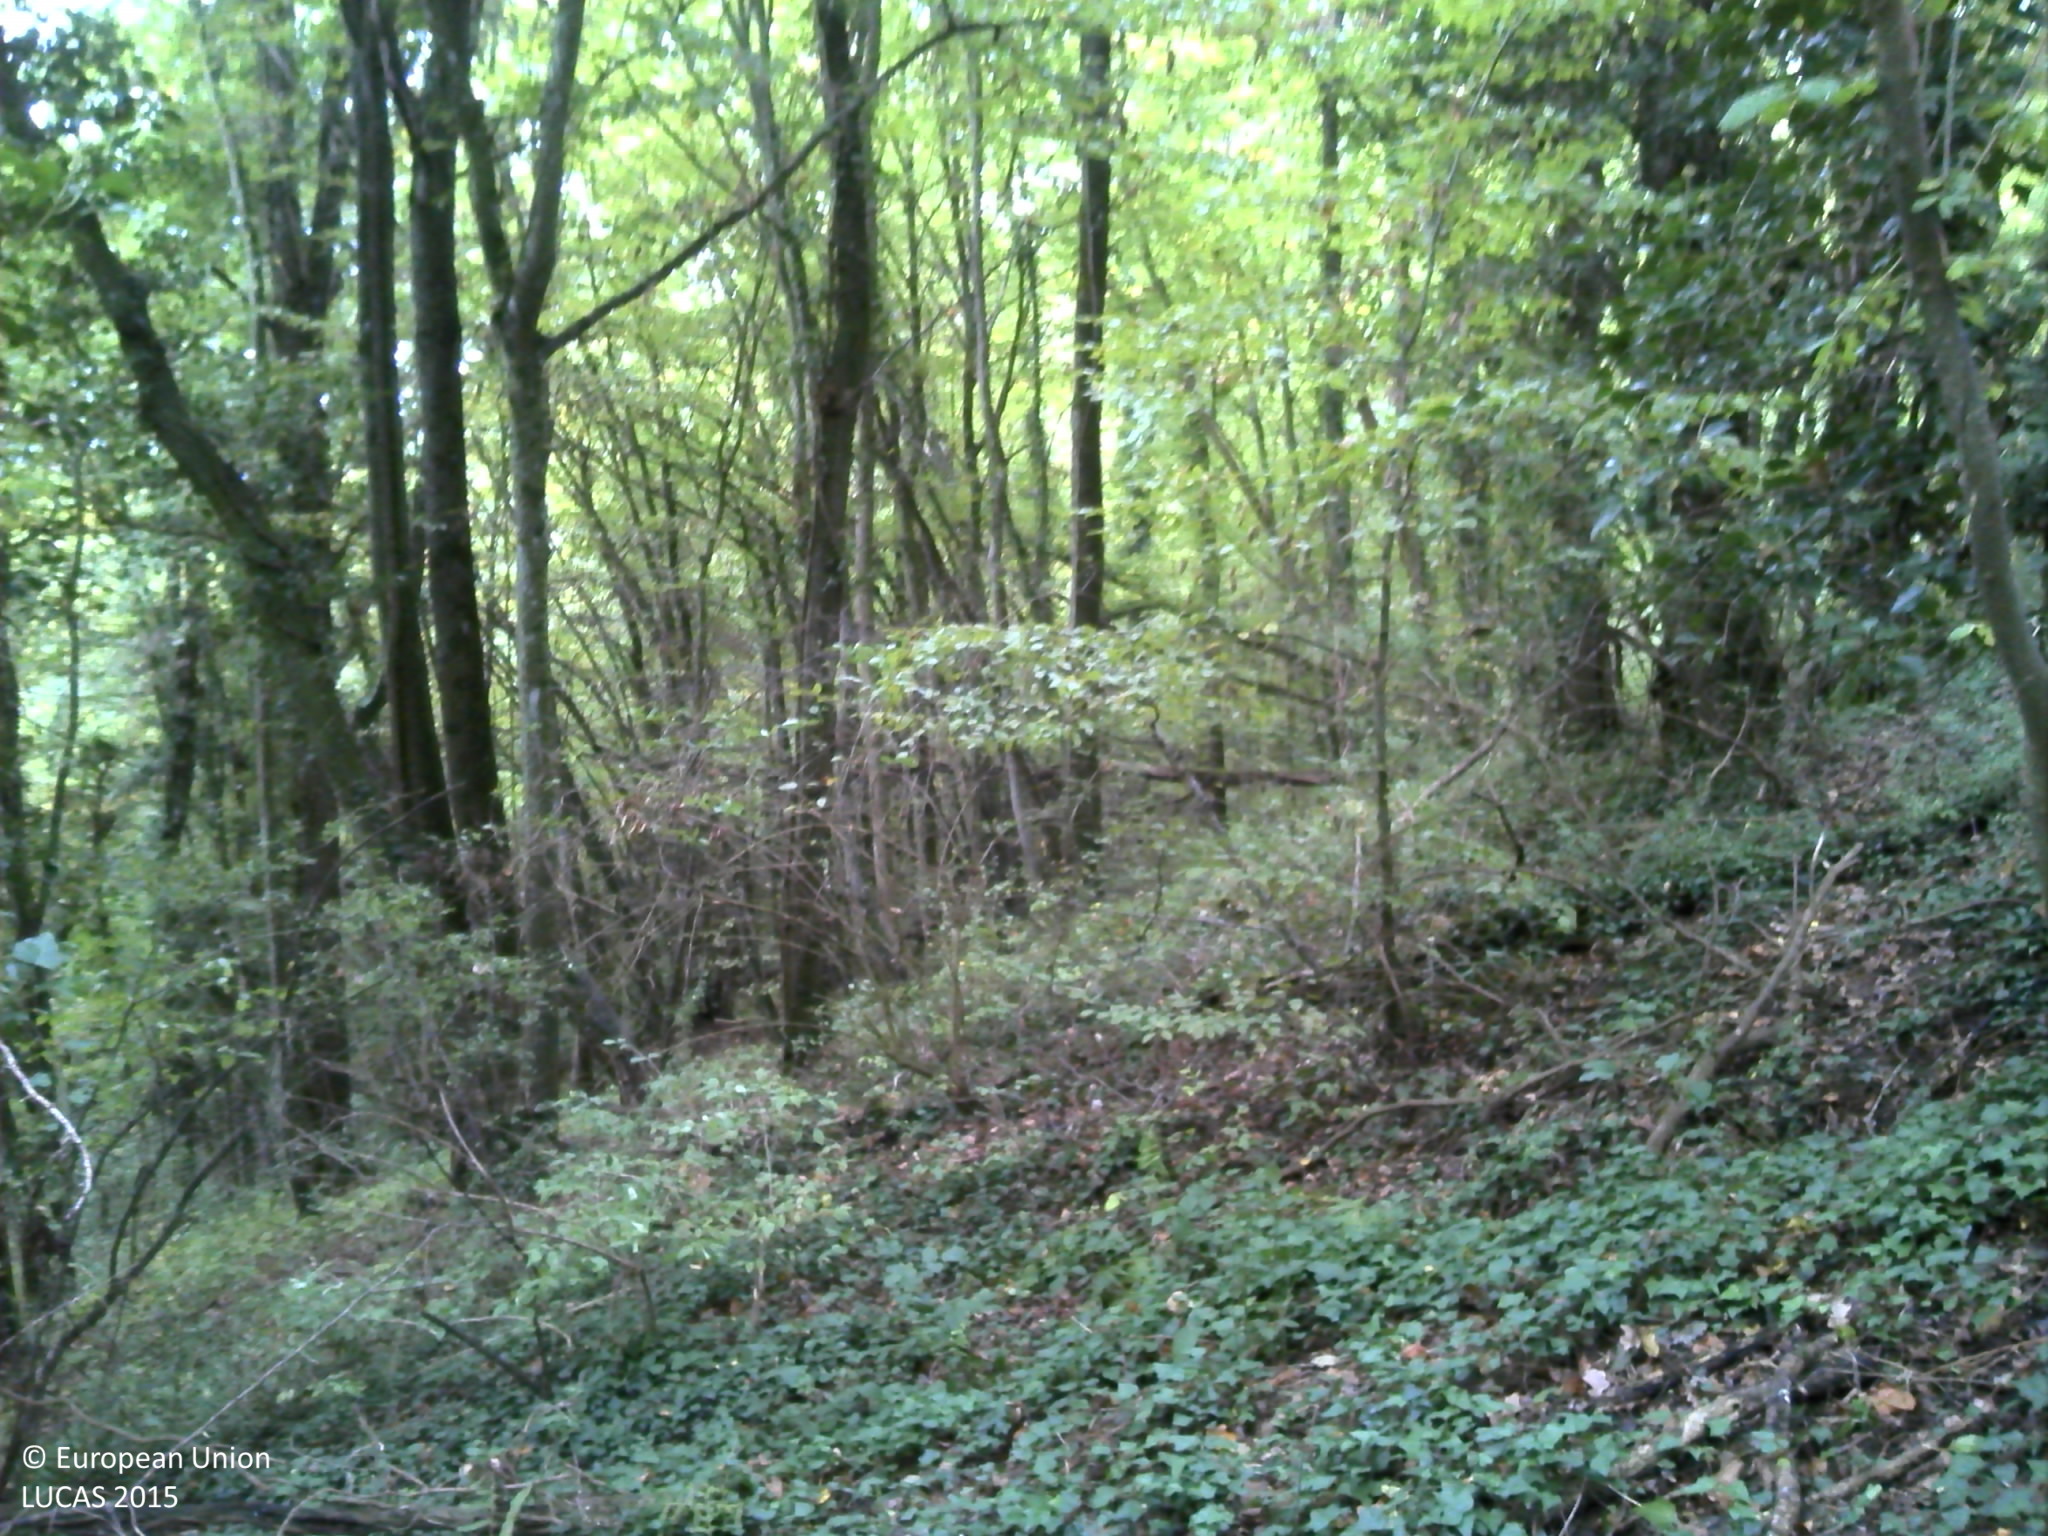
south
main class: Woodland
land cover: Broadleaved woodland
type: acidophilous oak and oak-birch forest
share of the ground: > 75 %
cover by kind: broadleaved forest trees 75 %, unconsolidated bare surface 15 %, herbaceous plants 10 %
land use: Forestry
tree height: > 5 m
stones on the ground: < 10 %
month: October
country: FR
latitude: 45.6197
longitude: 3.3449
